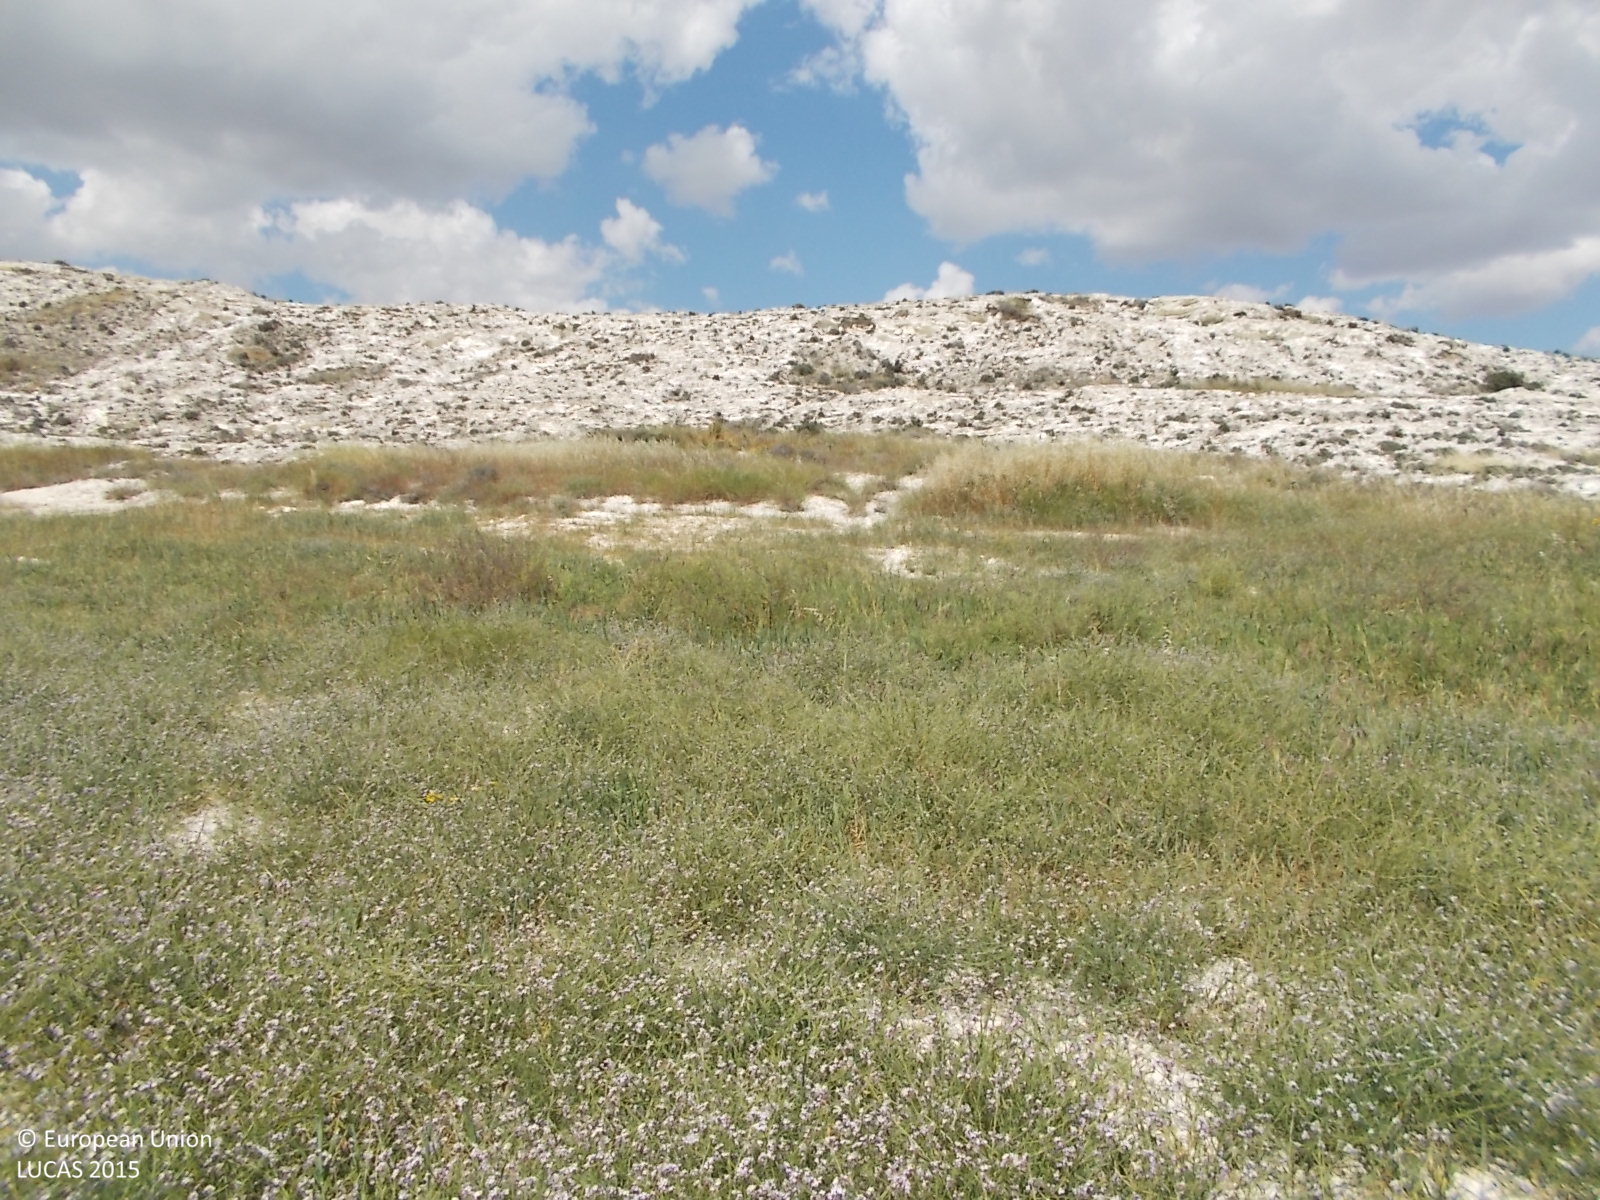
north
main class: Grassland
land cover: Spontaneously vegetated surfaces
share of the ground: > 75 %
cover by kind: herbaceous plants 85 %, unconsolidated bare surface 15 %
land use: Fallow land
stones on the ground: 10 - 25 %
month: April
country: CY
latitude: 34.9924
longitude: 33.6107
